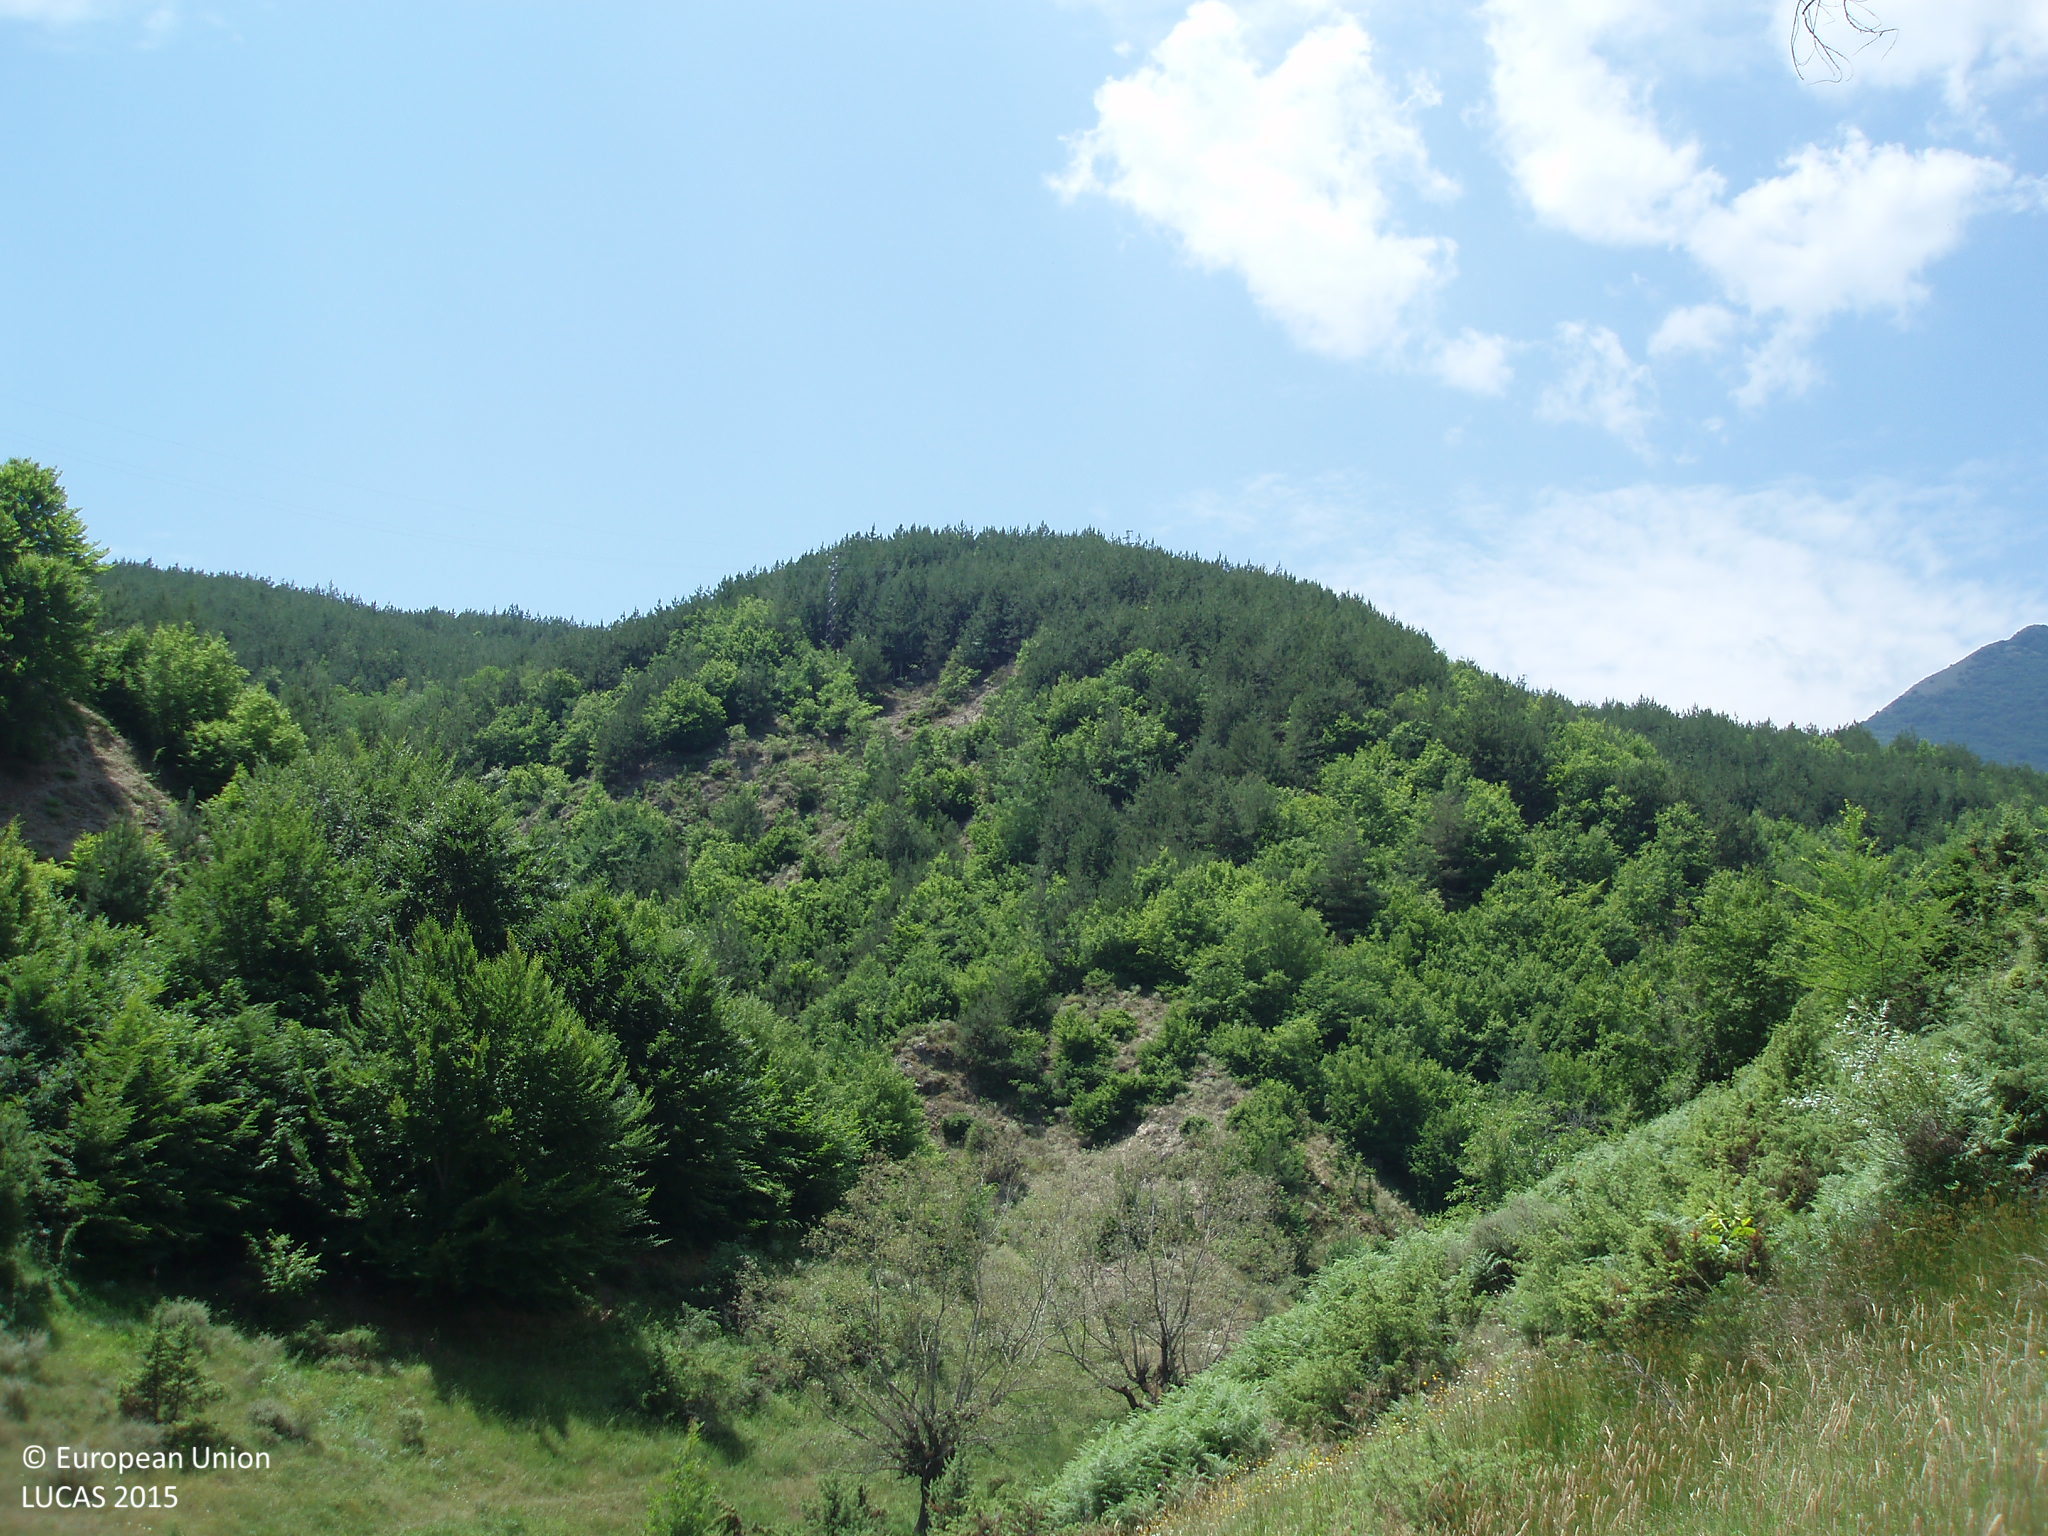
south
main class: Grassland
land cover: Grassland with sparse tree/shrub cover
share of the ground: > 75 %
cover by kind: herbaceous plants 90 %, broadleaved forest trees 5 %, shrubs 5 %
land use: Agriculture (excluding fallow land and kitchen gardens)
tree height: > 5 m
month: June
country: BG
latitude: 41.5913
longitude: 23.6917
